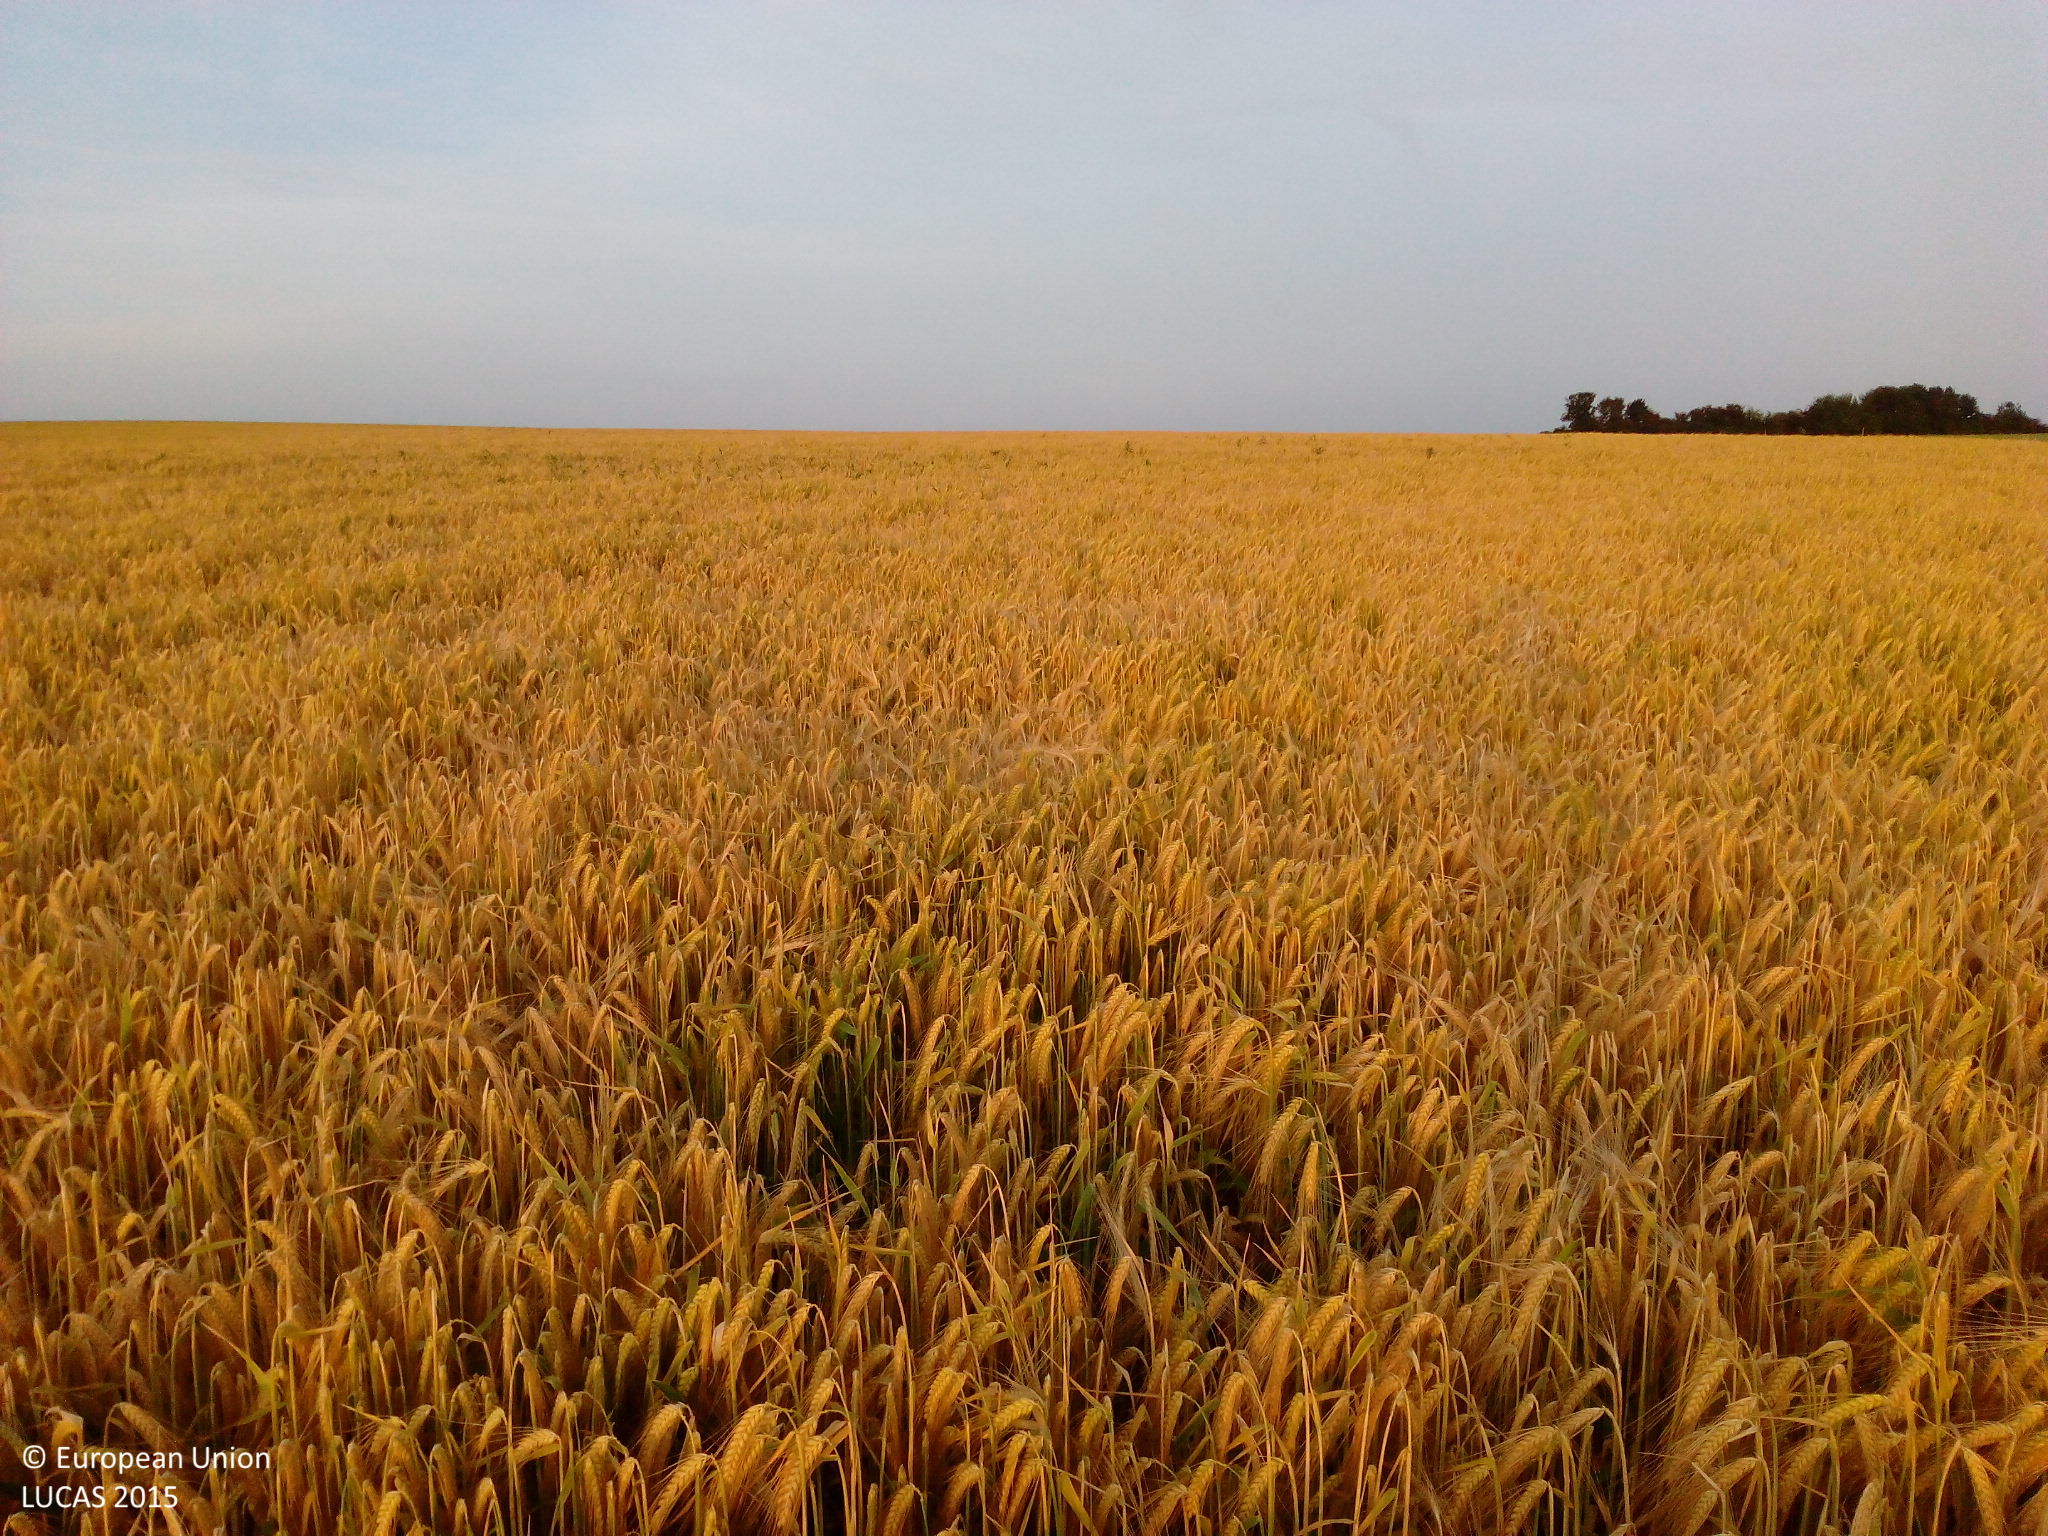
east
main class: Cropland
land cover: Barley
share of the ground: > 75 %
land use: Agriculture (excluding fallow land and kitchen gardens)
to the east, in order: Barley; Common wheat
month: June
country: DE
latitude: 49.3381
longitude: 9.5735
